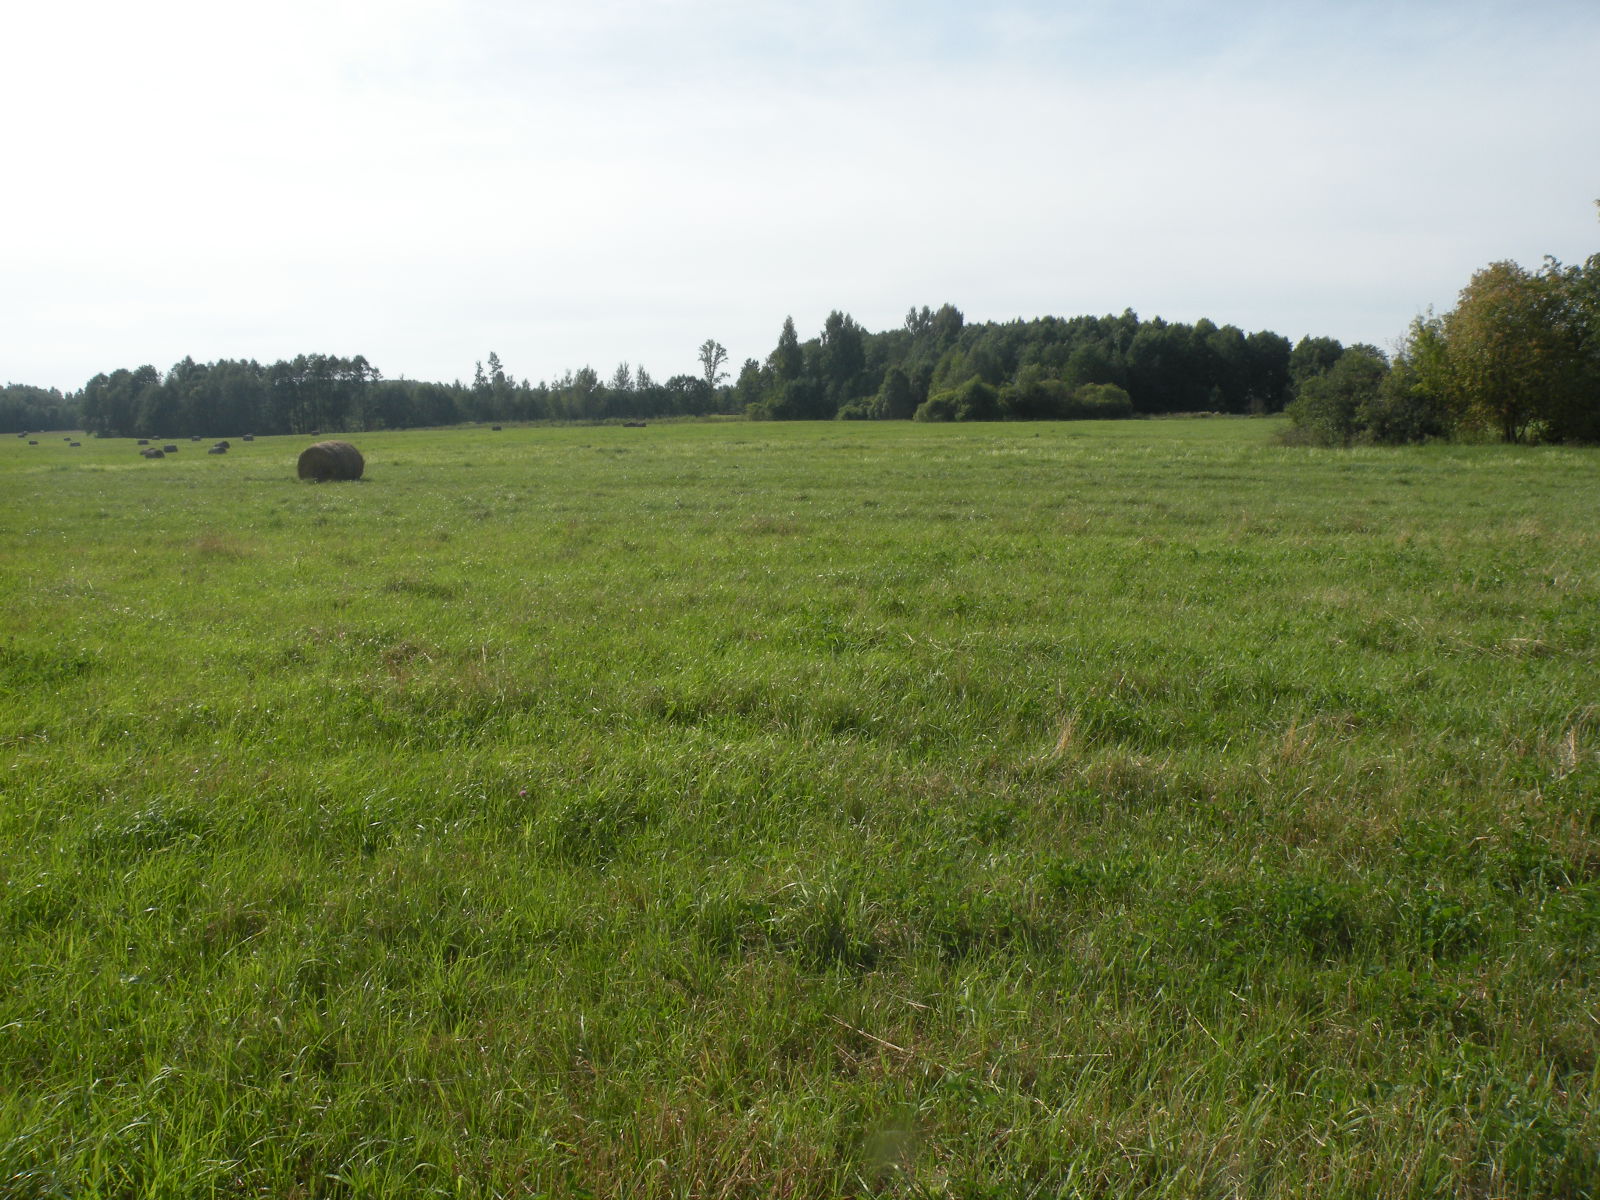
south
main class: Grassland
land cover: Grassland without tree/shrub cover
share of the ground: > 75 %
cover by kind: herbaceous plants 100 %
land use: Agriculture (excluding fallow land and kitchen gardens)
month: August
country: LV
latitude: 55.9387
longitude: 26.1991
